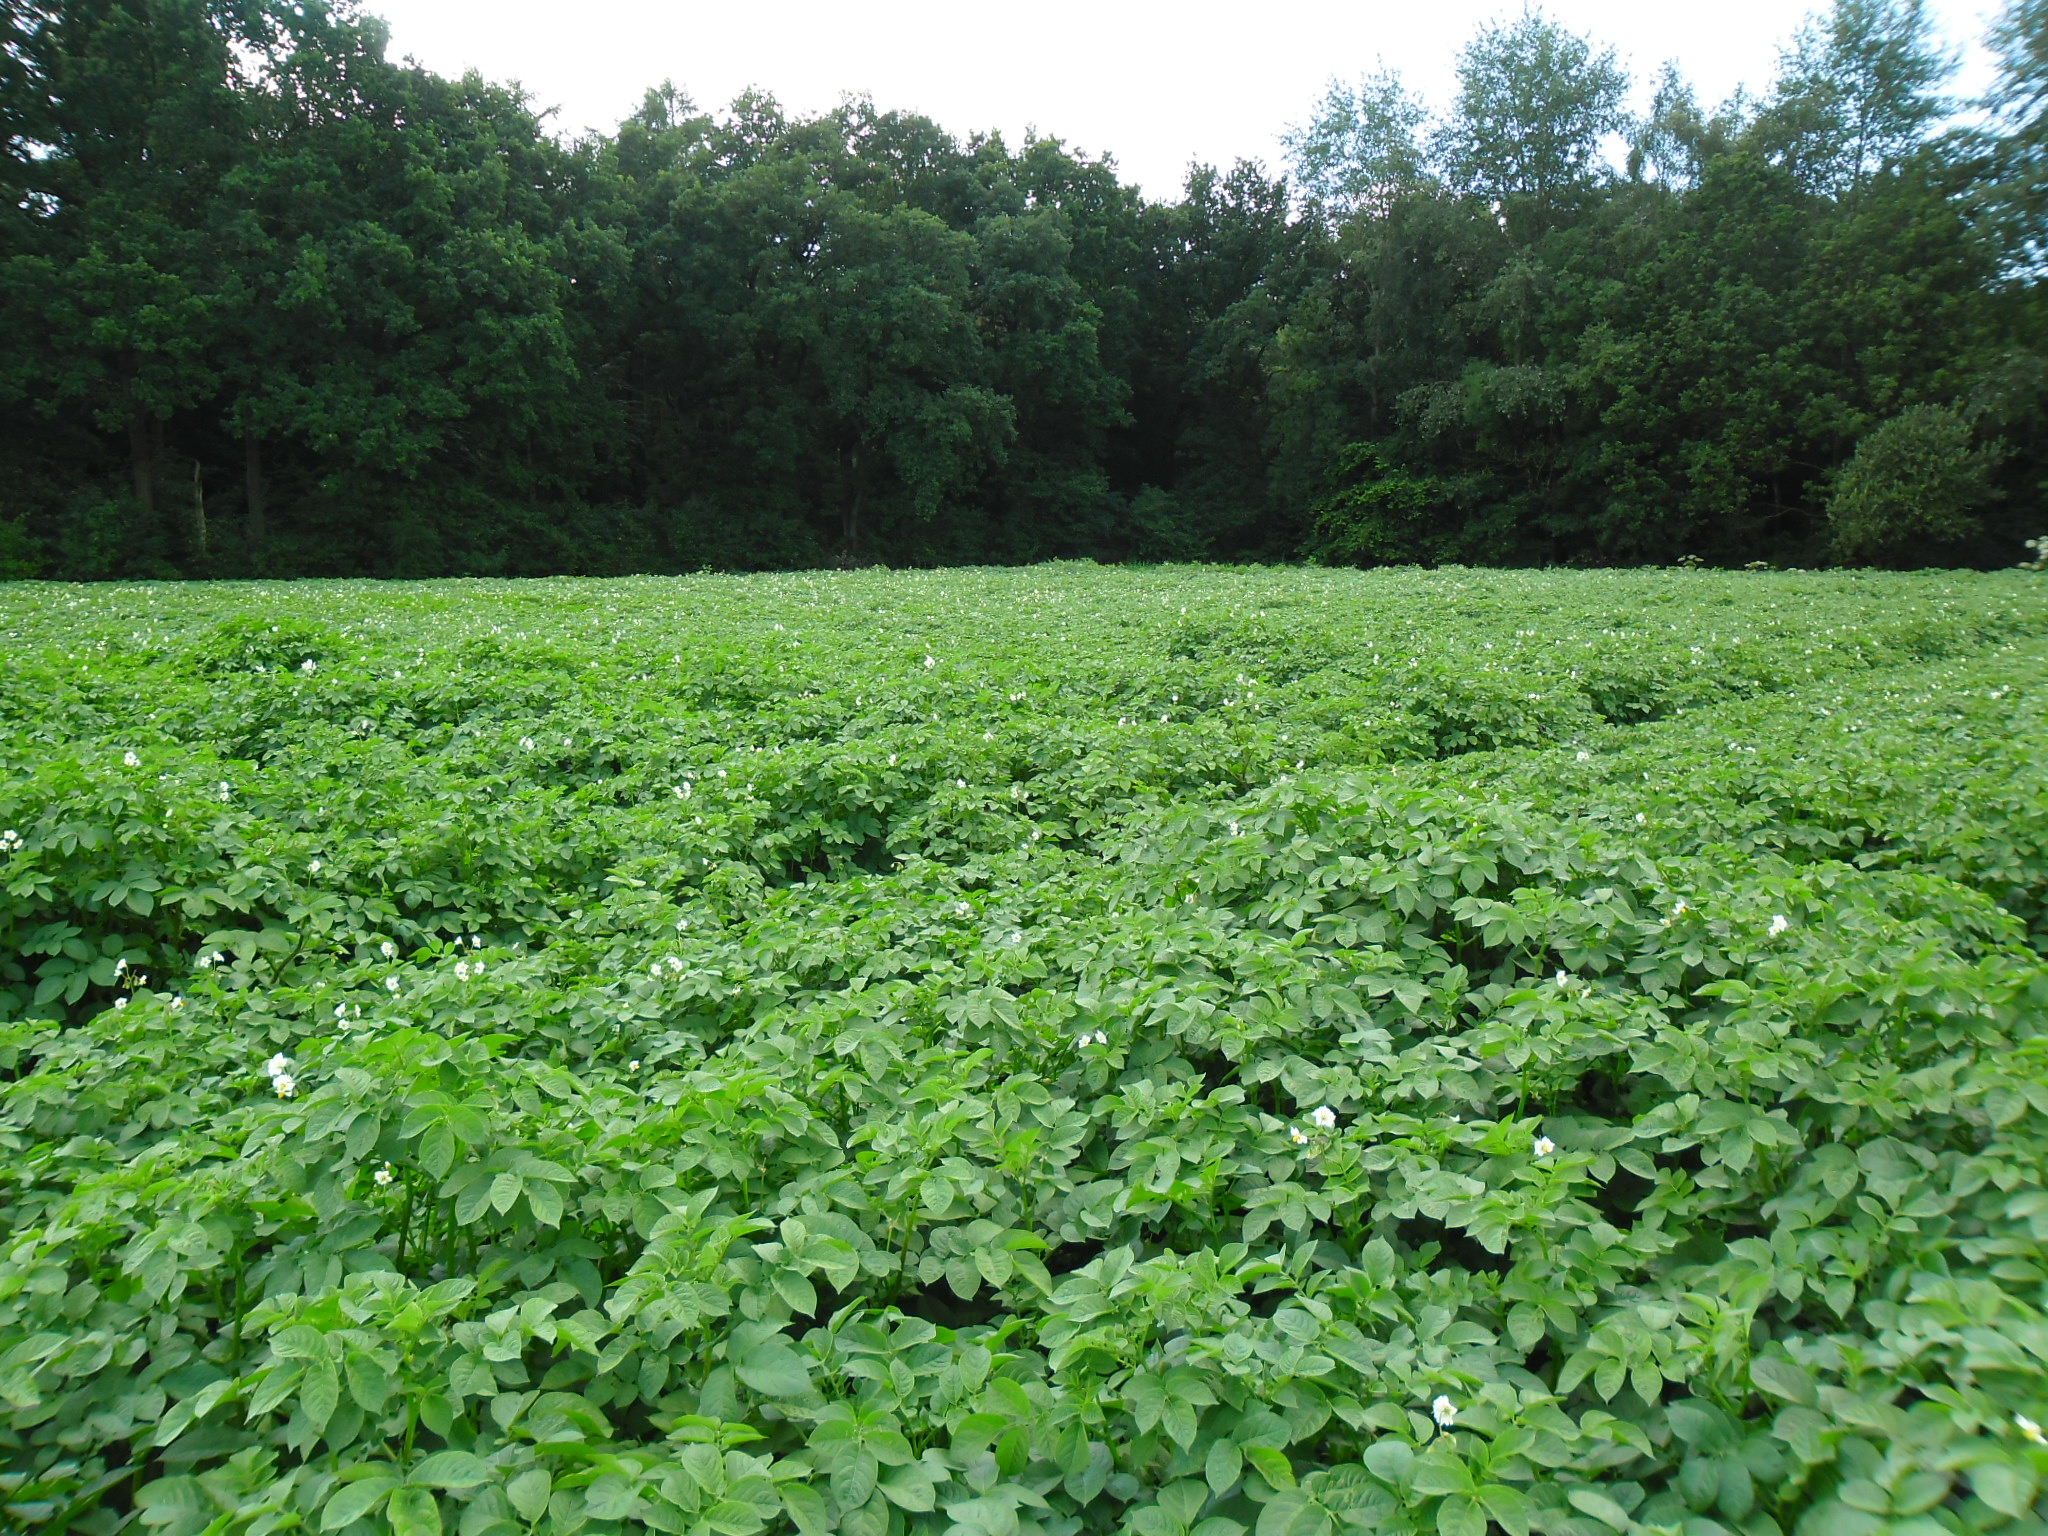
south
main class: Cropland
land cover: Potatoes
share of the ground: > 75 %
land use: Agriculture (excluding fallow land and kitchen gardens)
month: July
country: NL
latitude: 52.8538
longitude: 6.7182
